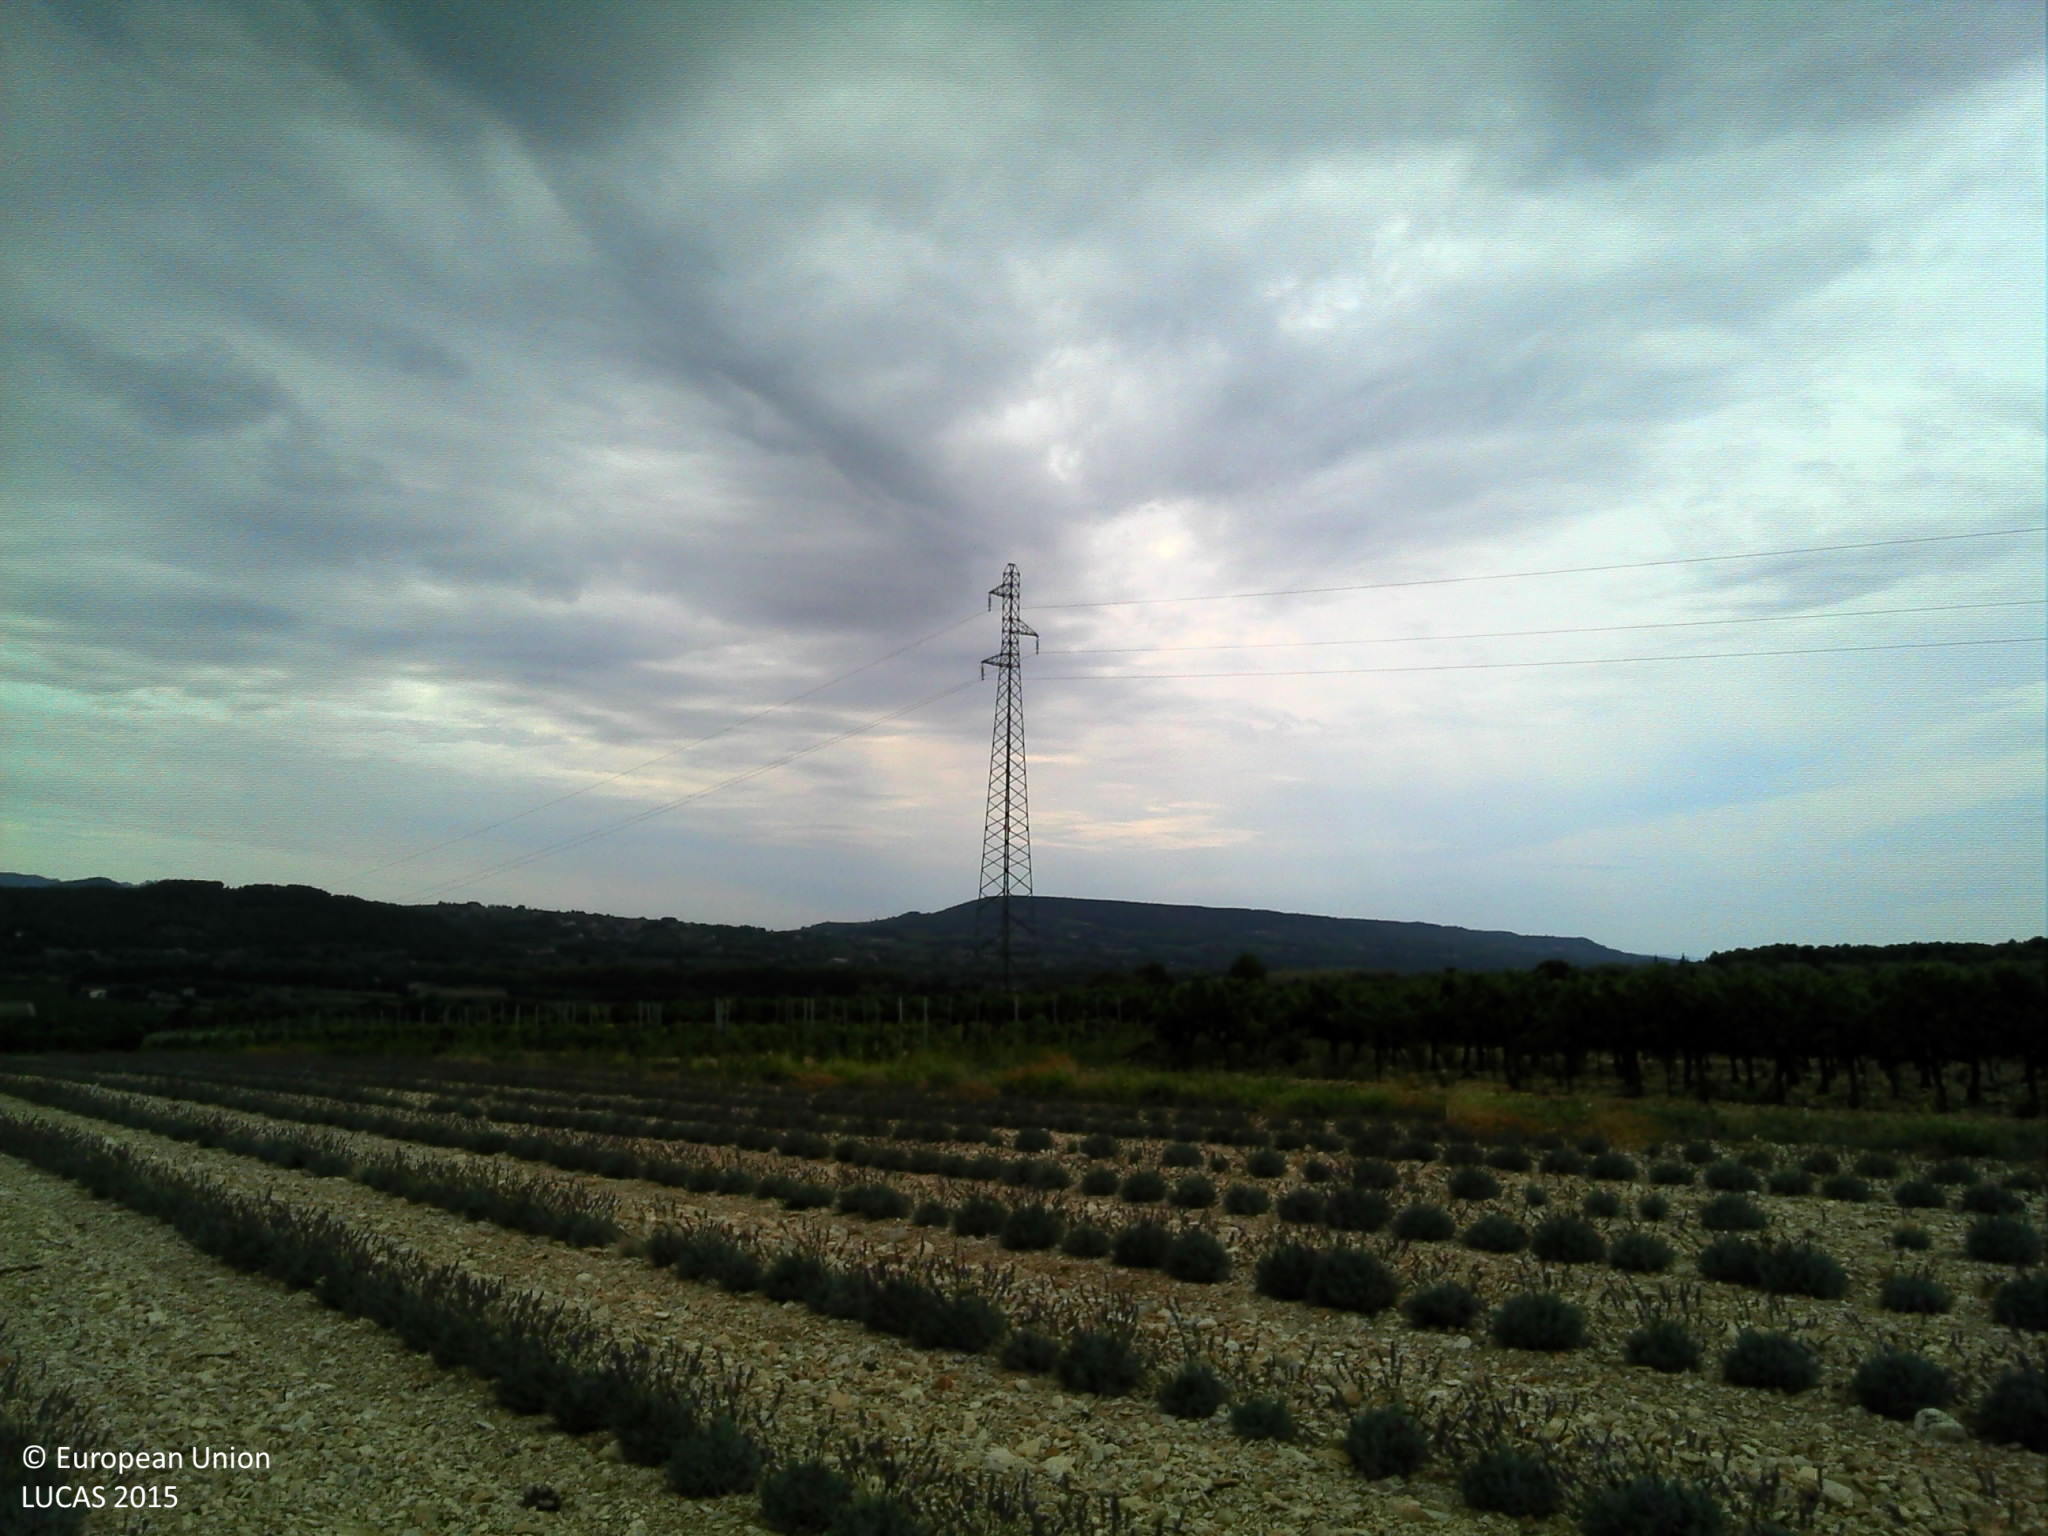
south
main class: Cropland
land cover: Permanent industrial crops
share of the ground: 10 - 25 %
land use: Agriculture (excluding fallow land and kitchen gardens)
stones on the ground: 25 - 50 %
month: September
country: FR
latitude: 44.3230
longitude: 5.0545
